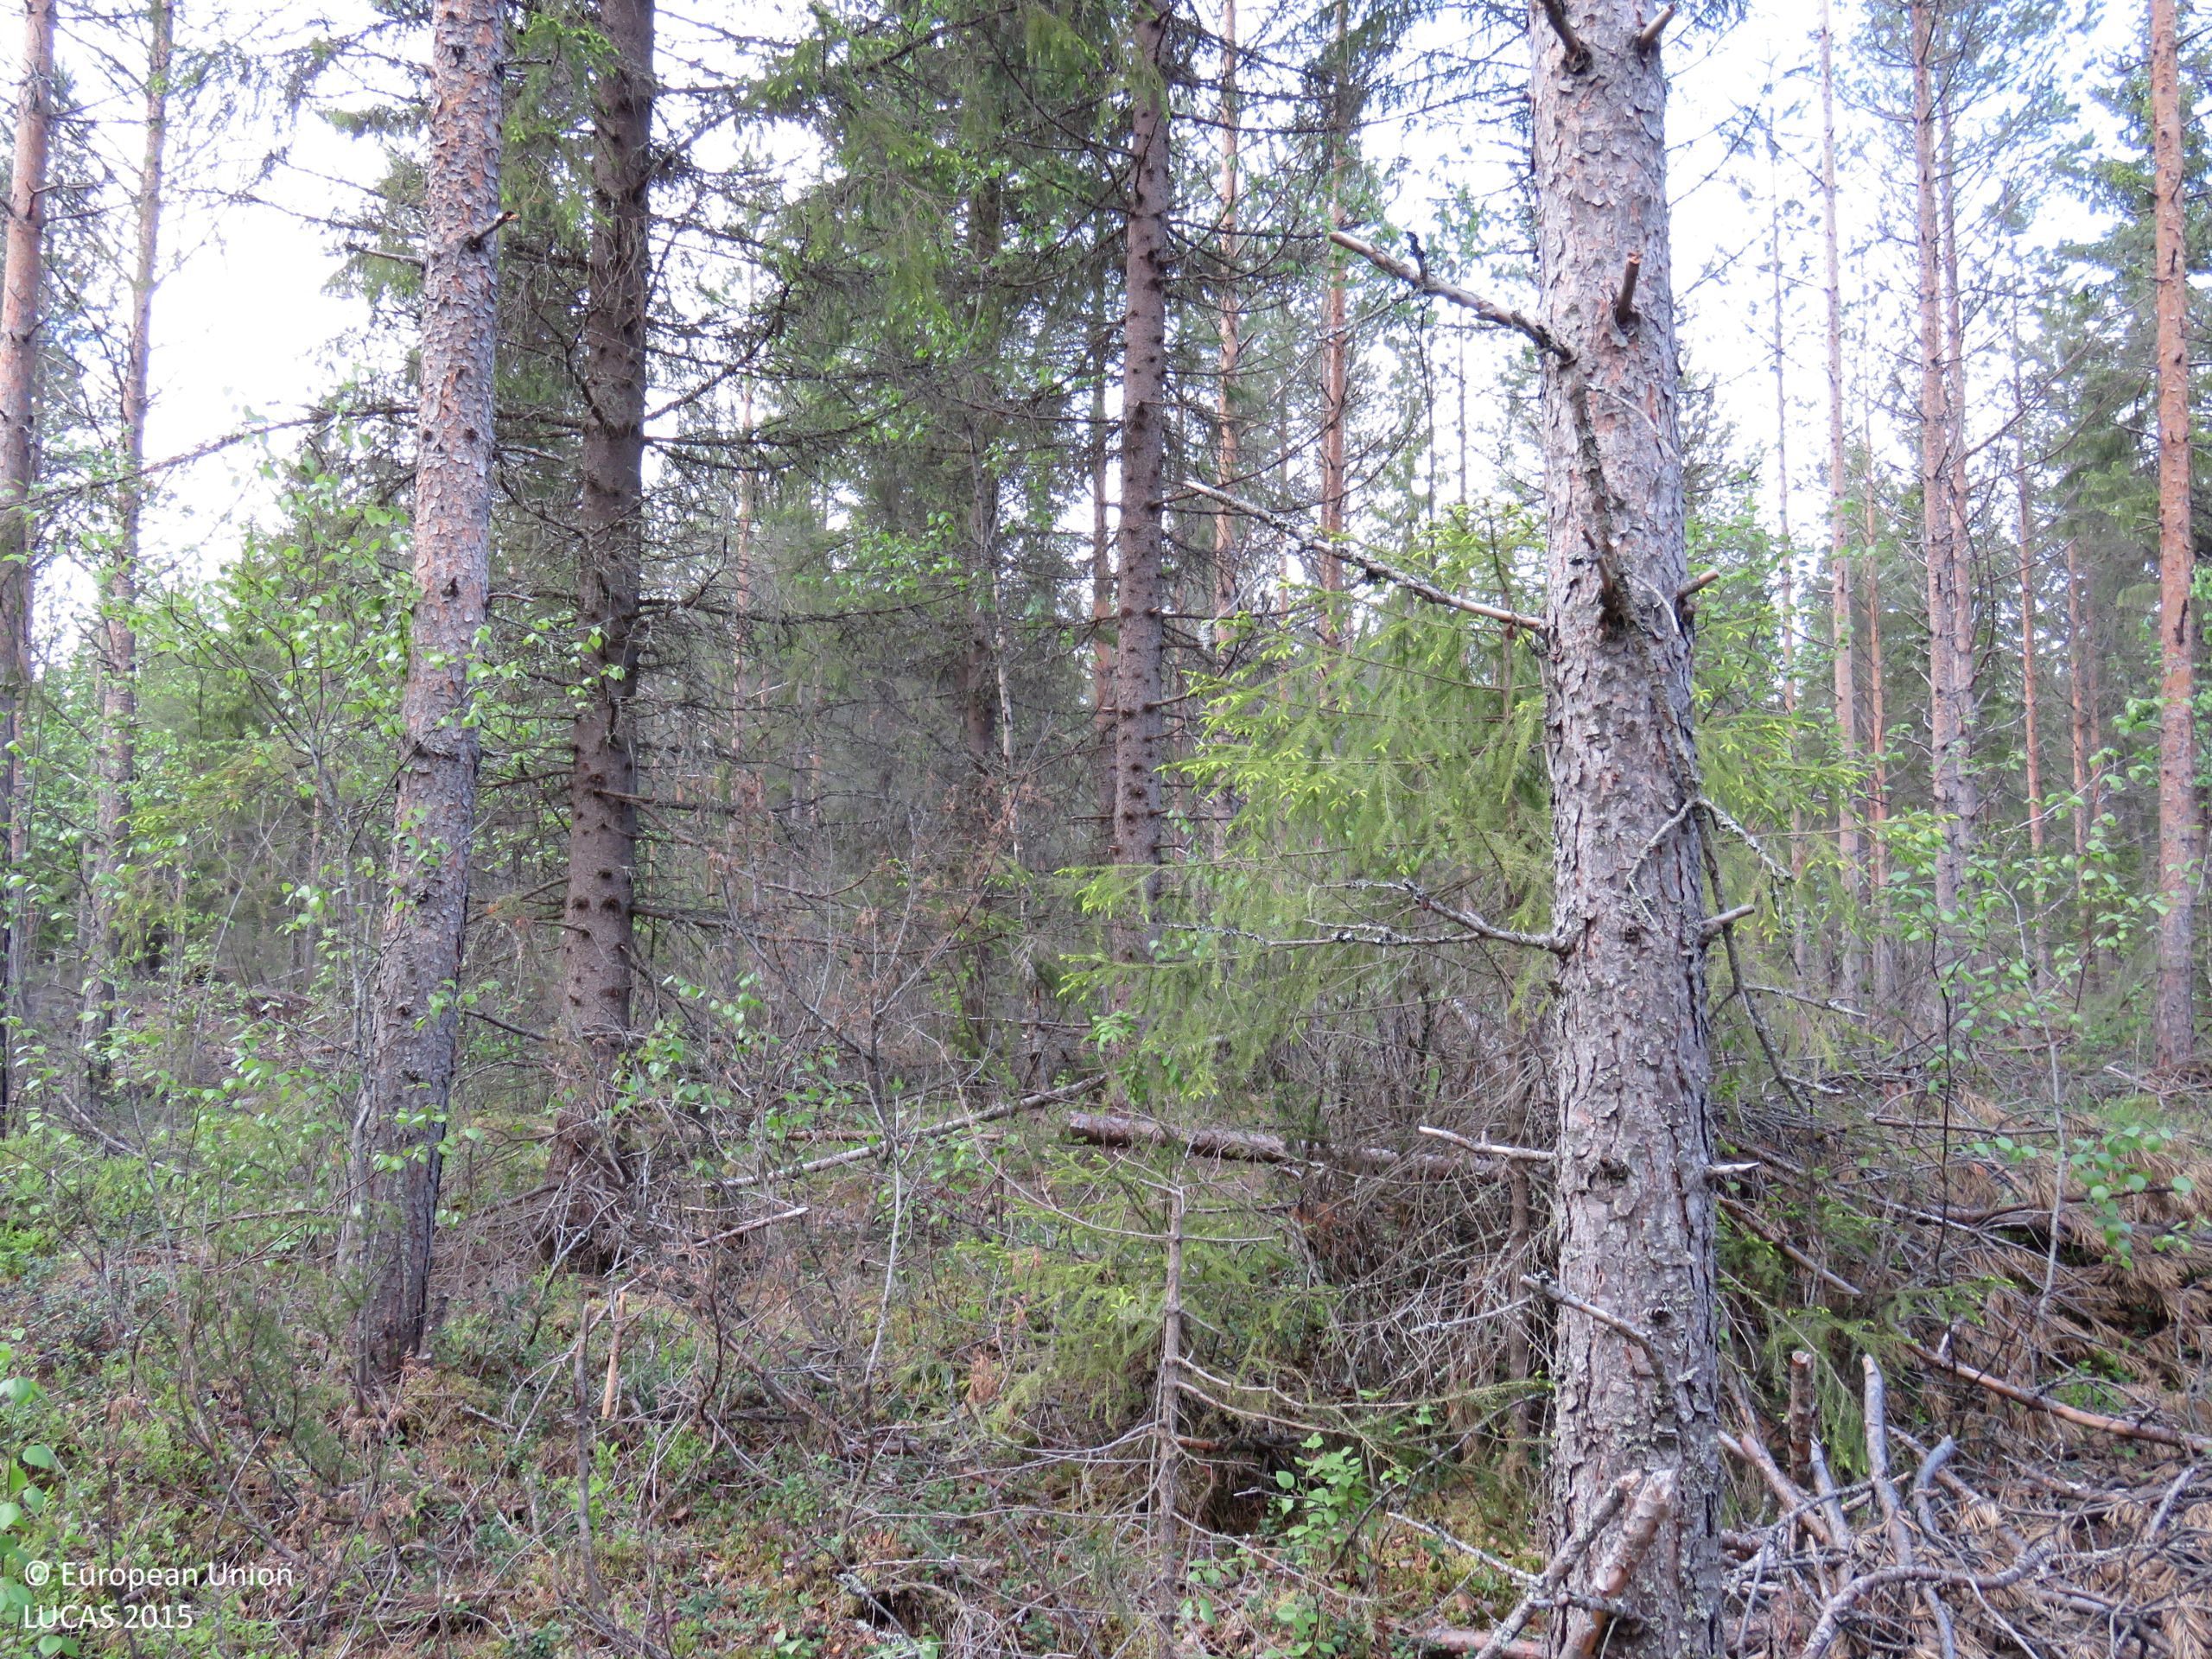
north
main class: Woodland
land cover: Other coniferous woodland
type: boreal forest
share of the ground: 50 - 75 %
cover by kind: coniferous forest trees 60 %, shrubs 30 %, broadleaved forest trees 5 %, lichens and mosses 5 %
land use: Forestry
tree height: > 5 m
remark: Clear cut
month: June
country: FI
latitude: 65.0524
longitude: 25.7053
